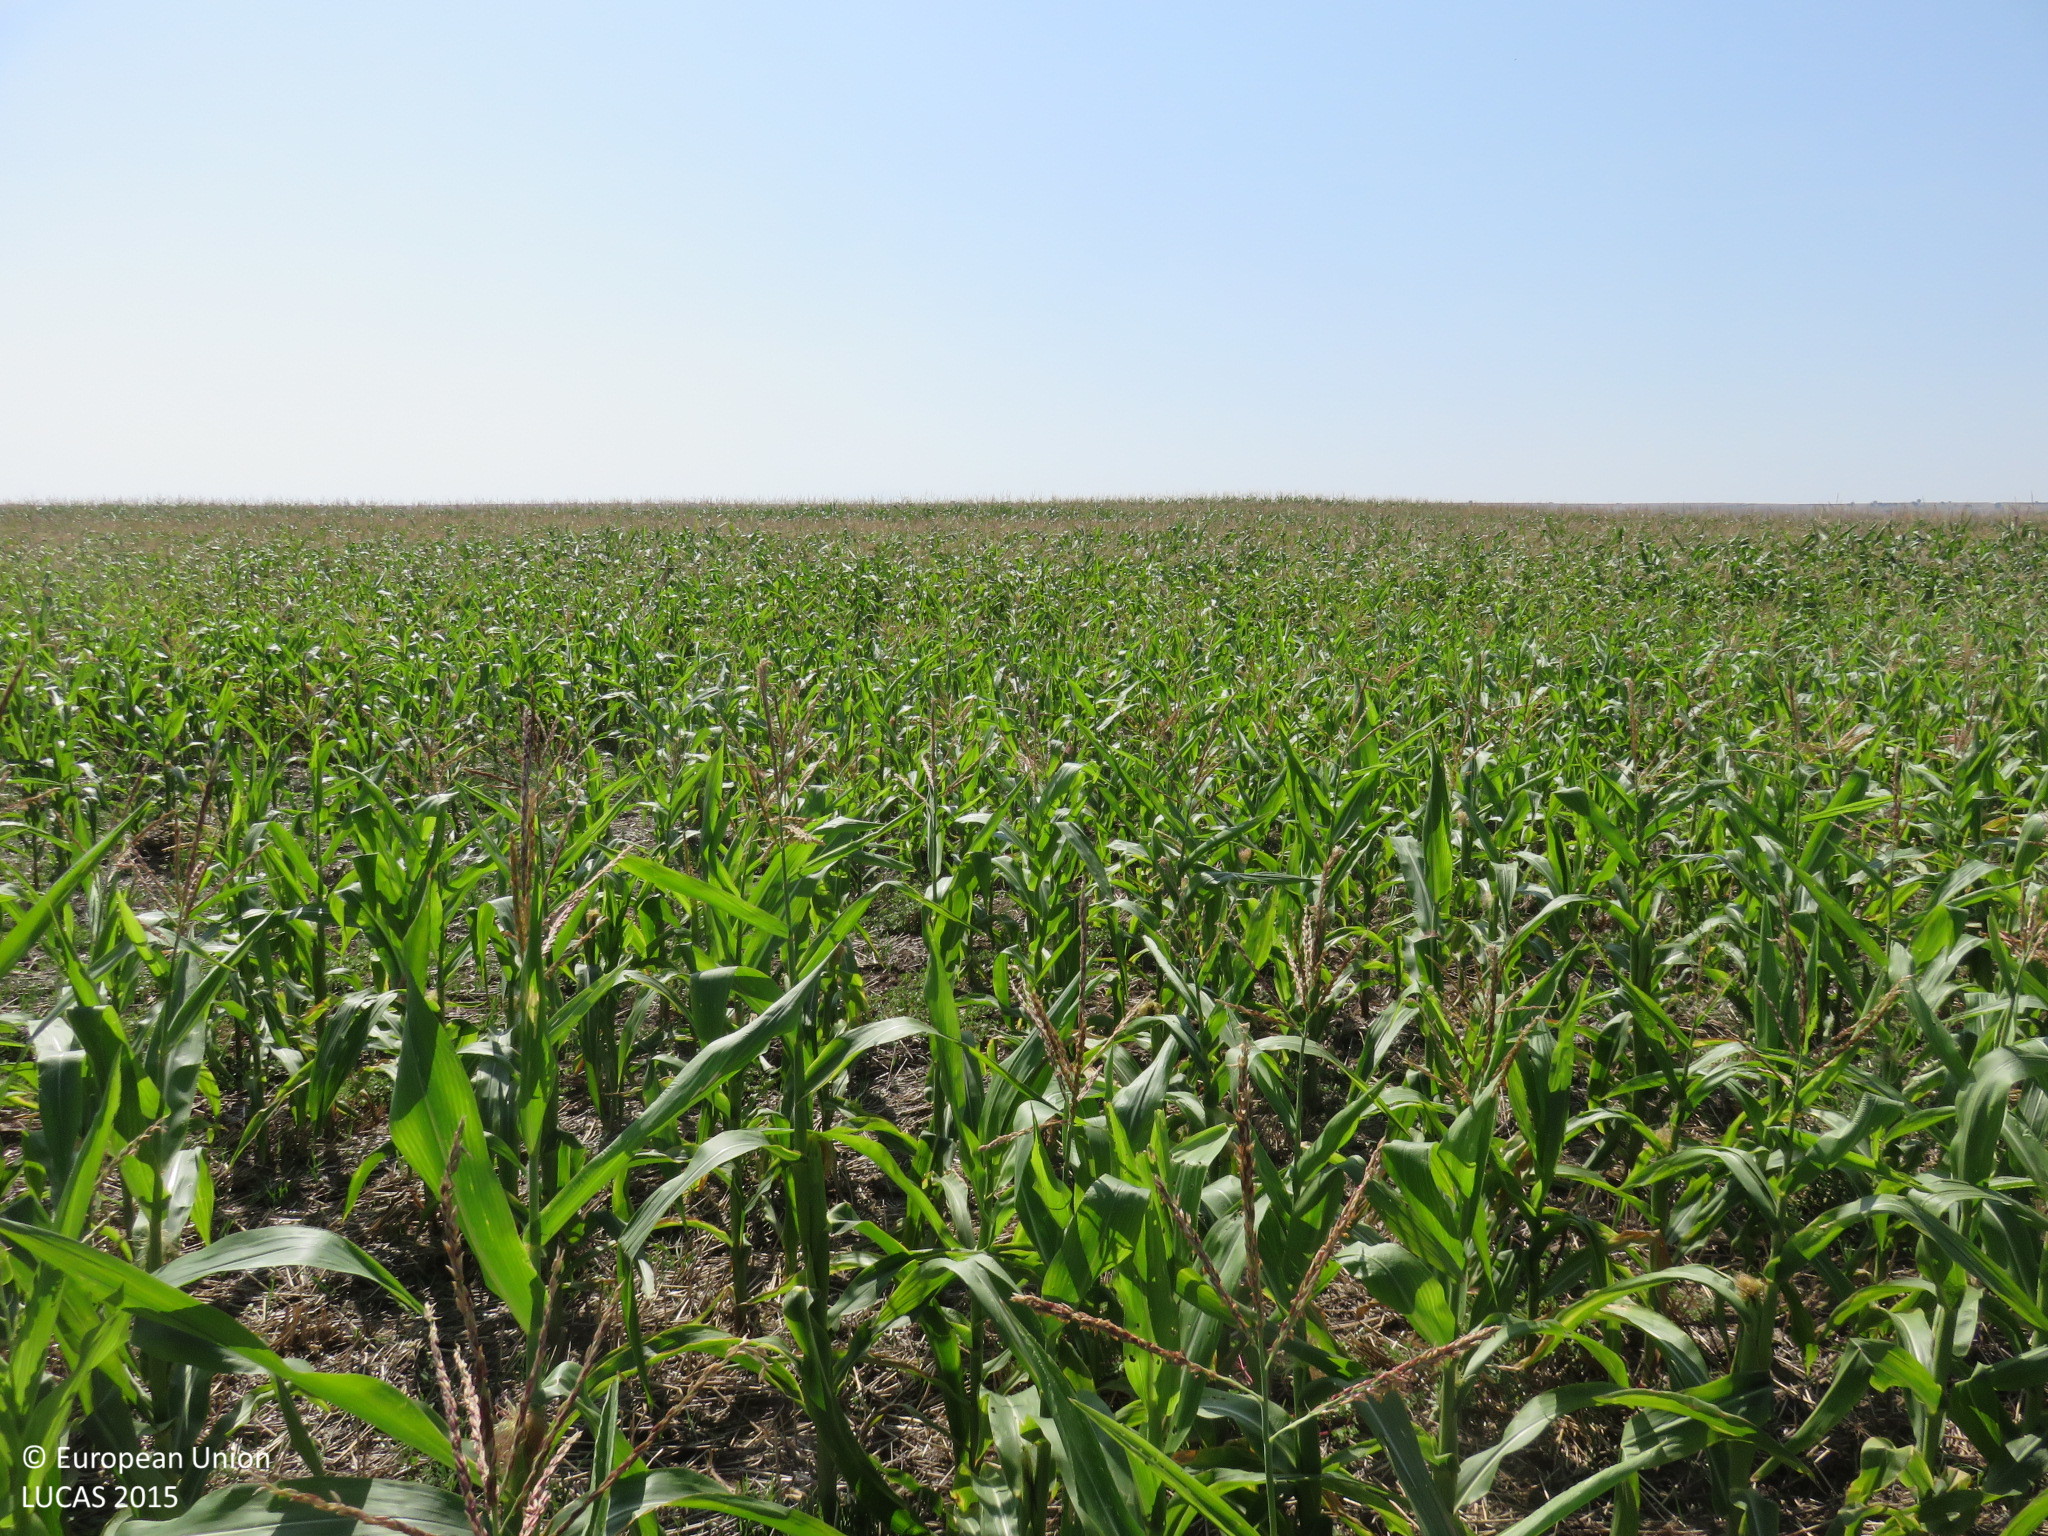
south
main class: Cropland
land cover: Maize
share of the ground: 50 - 75 %
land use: Agriculture (excluding fallow land and kitchen gardens)
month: September
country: BG
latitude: 43.6578
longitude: 24.6102
